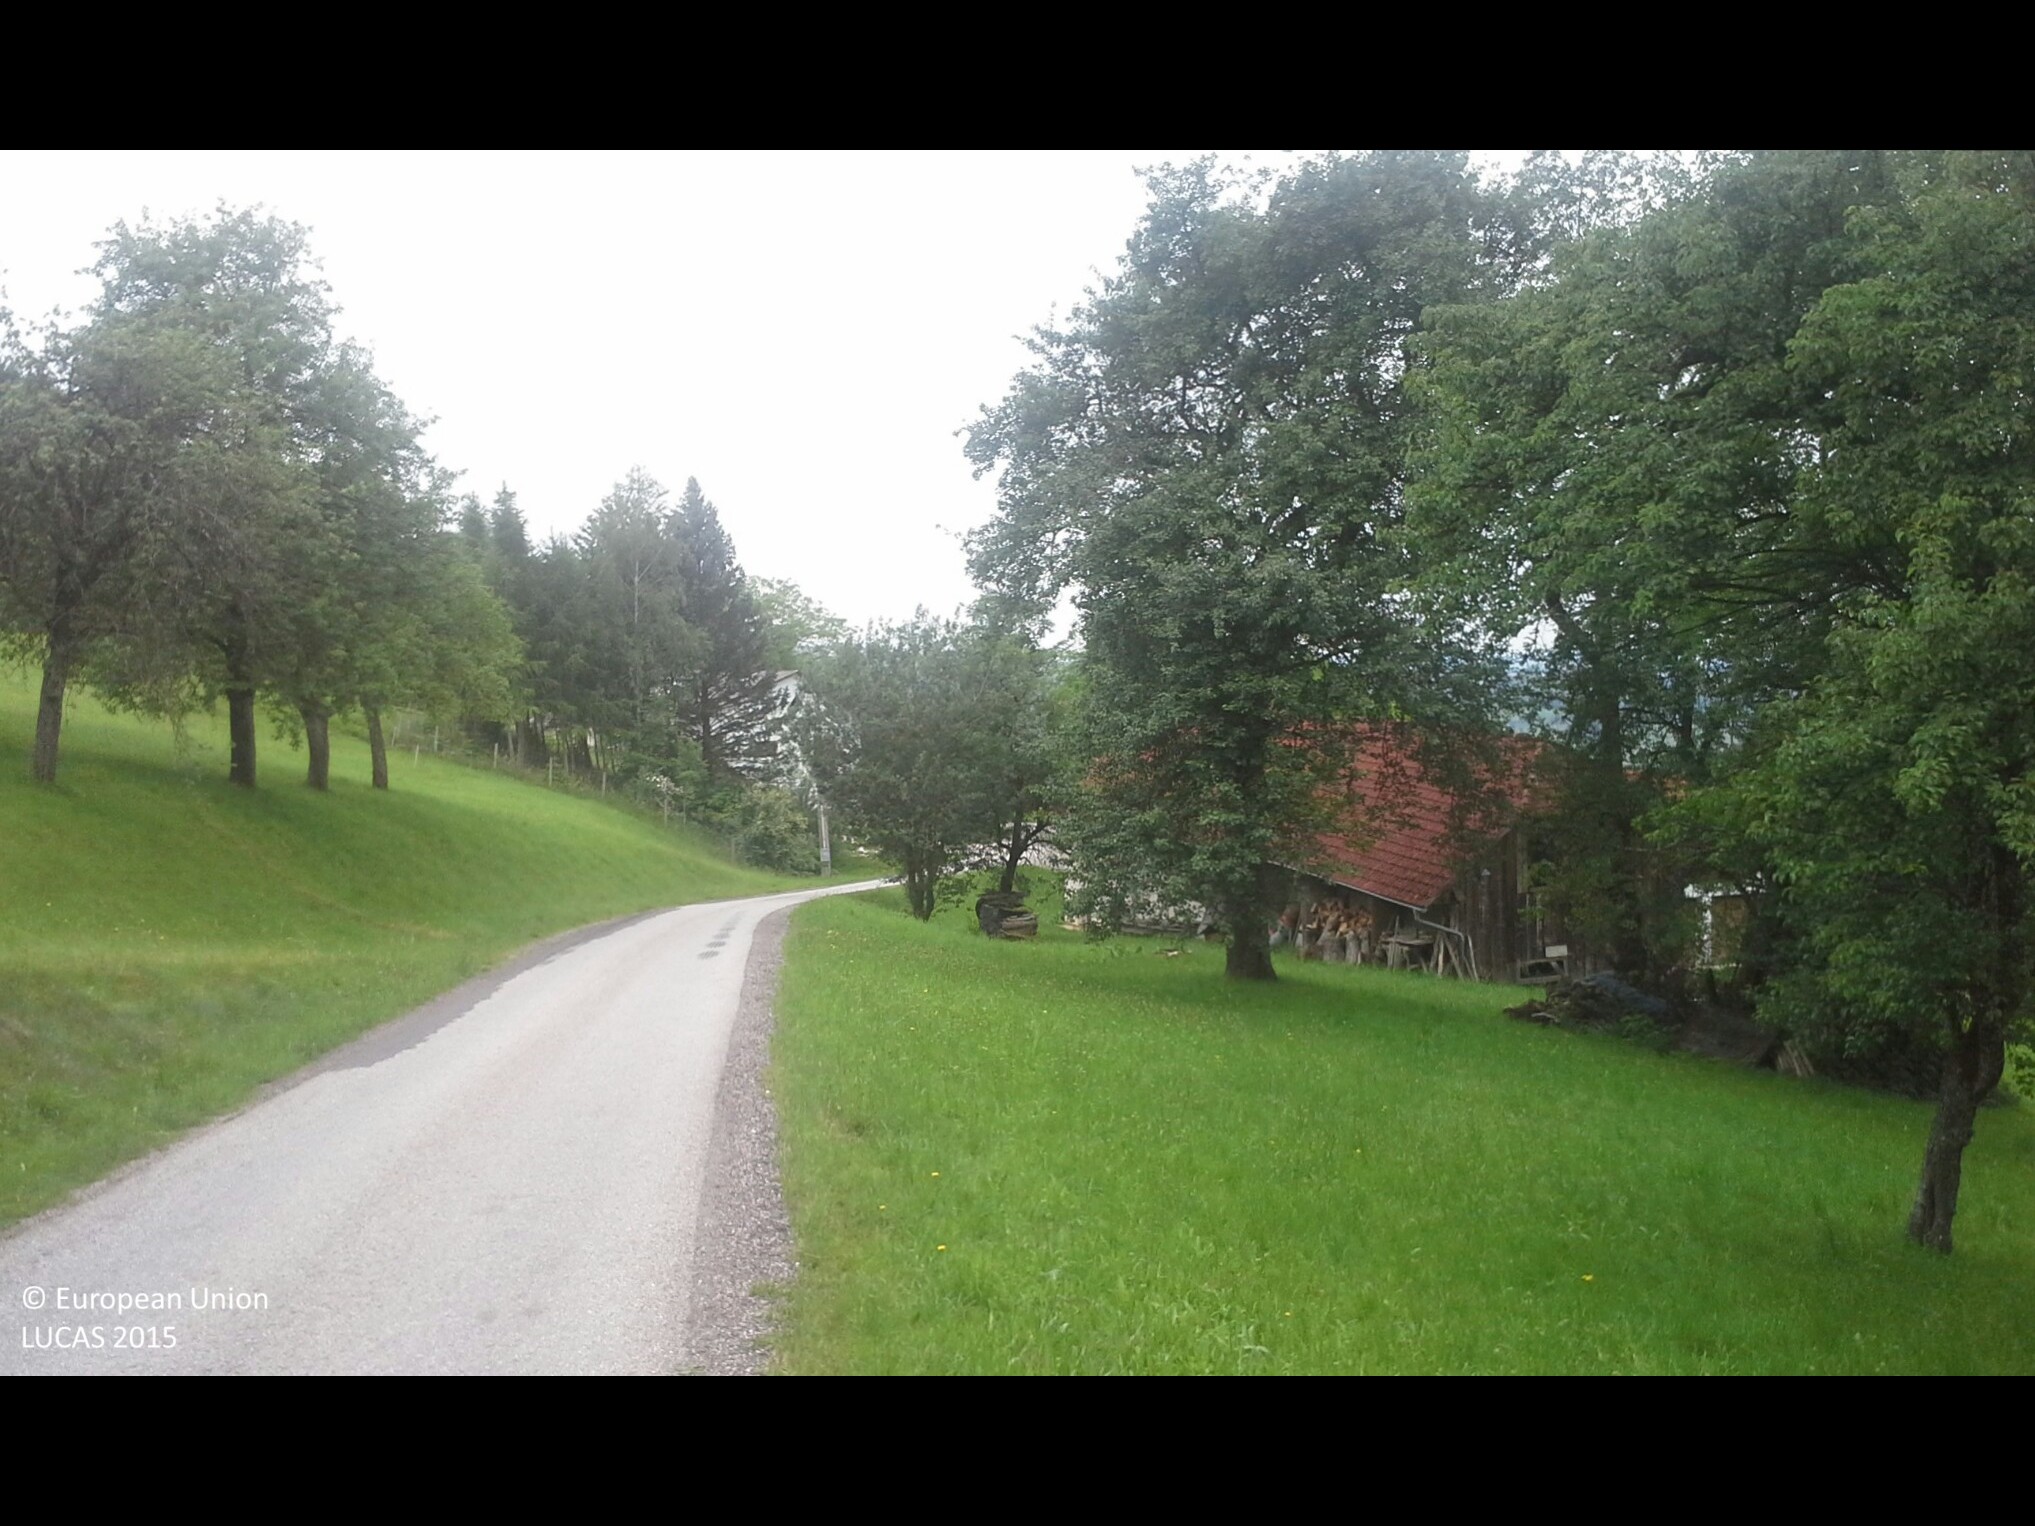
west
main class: Grassland
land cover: Grassland without tree/shrub cover
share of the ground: > 75 %
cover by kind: herbaceous plants 100 %
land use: Agriculture (excluding fallow land and kitchen gardens)
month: June
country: AT
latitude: 47.9775
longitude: 14.3001
